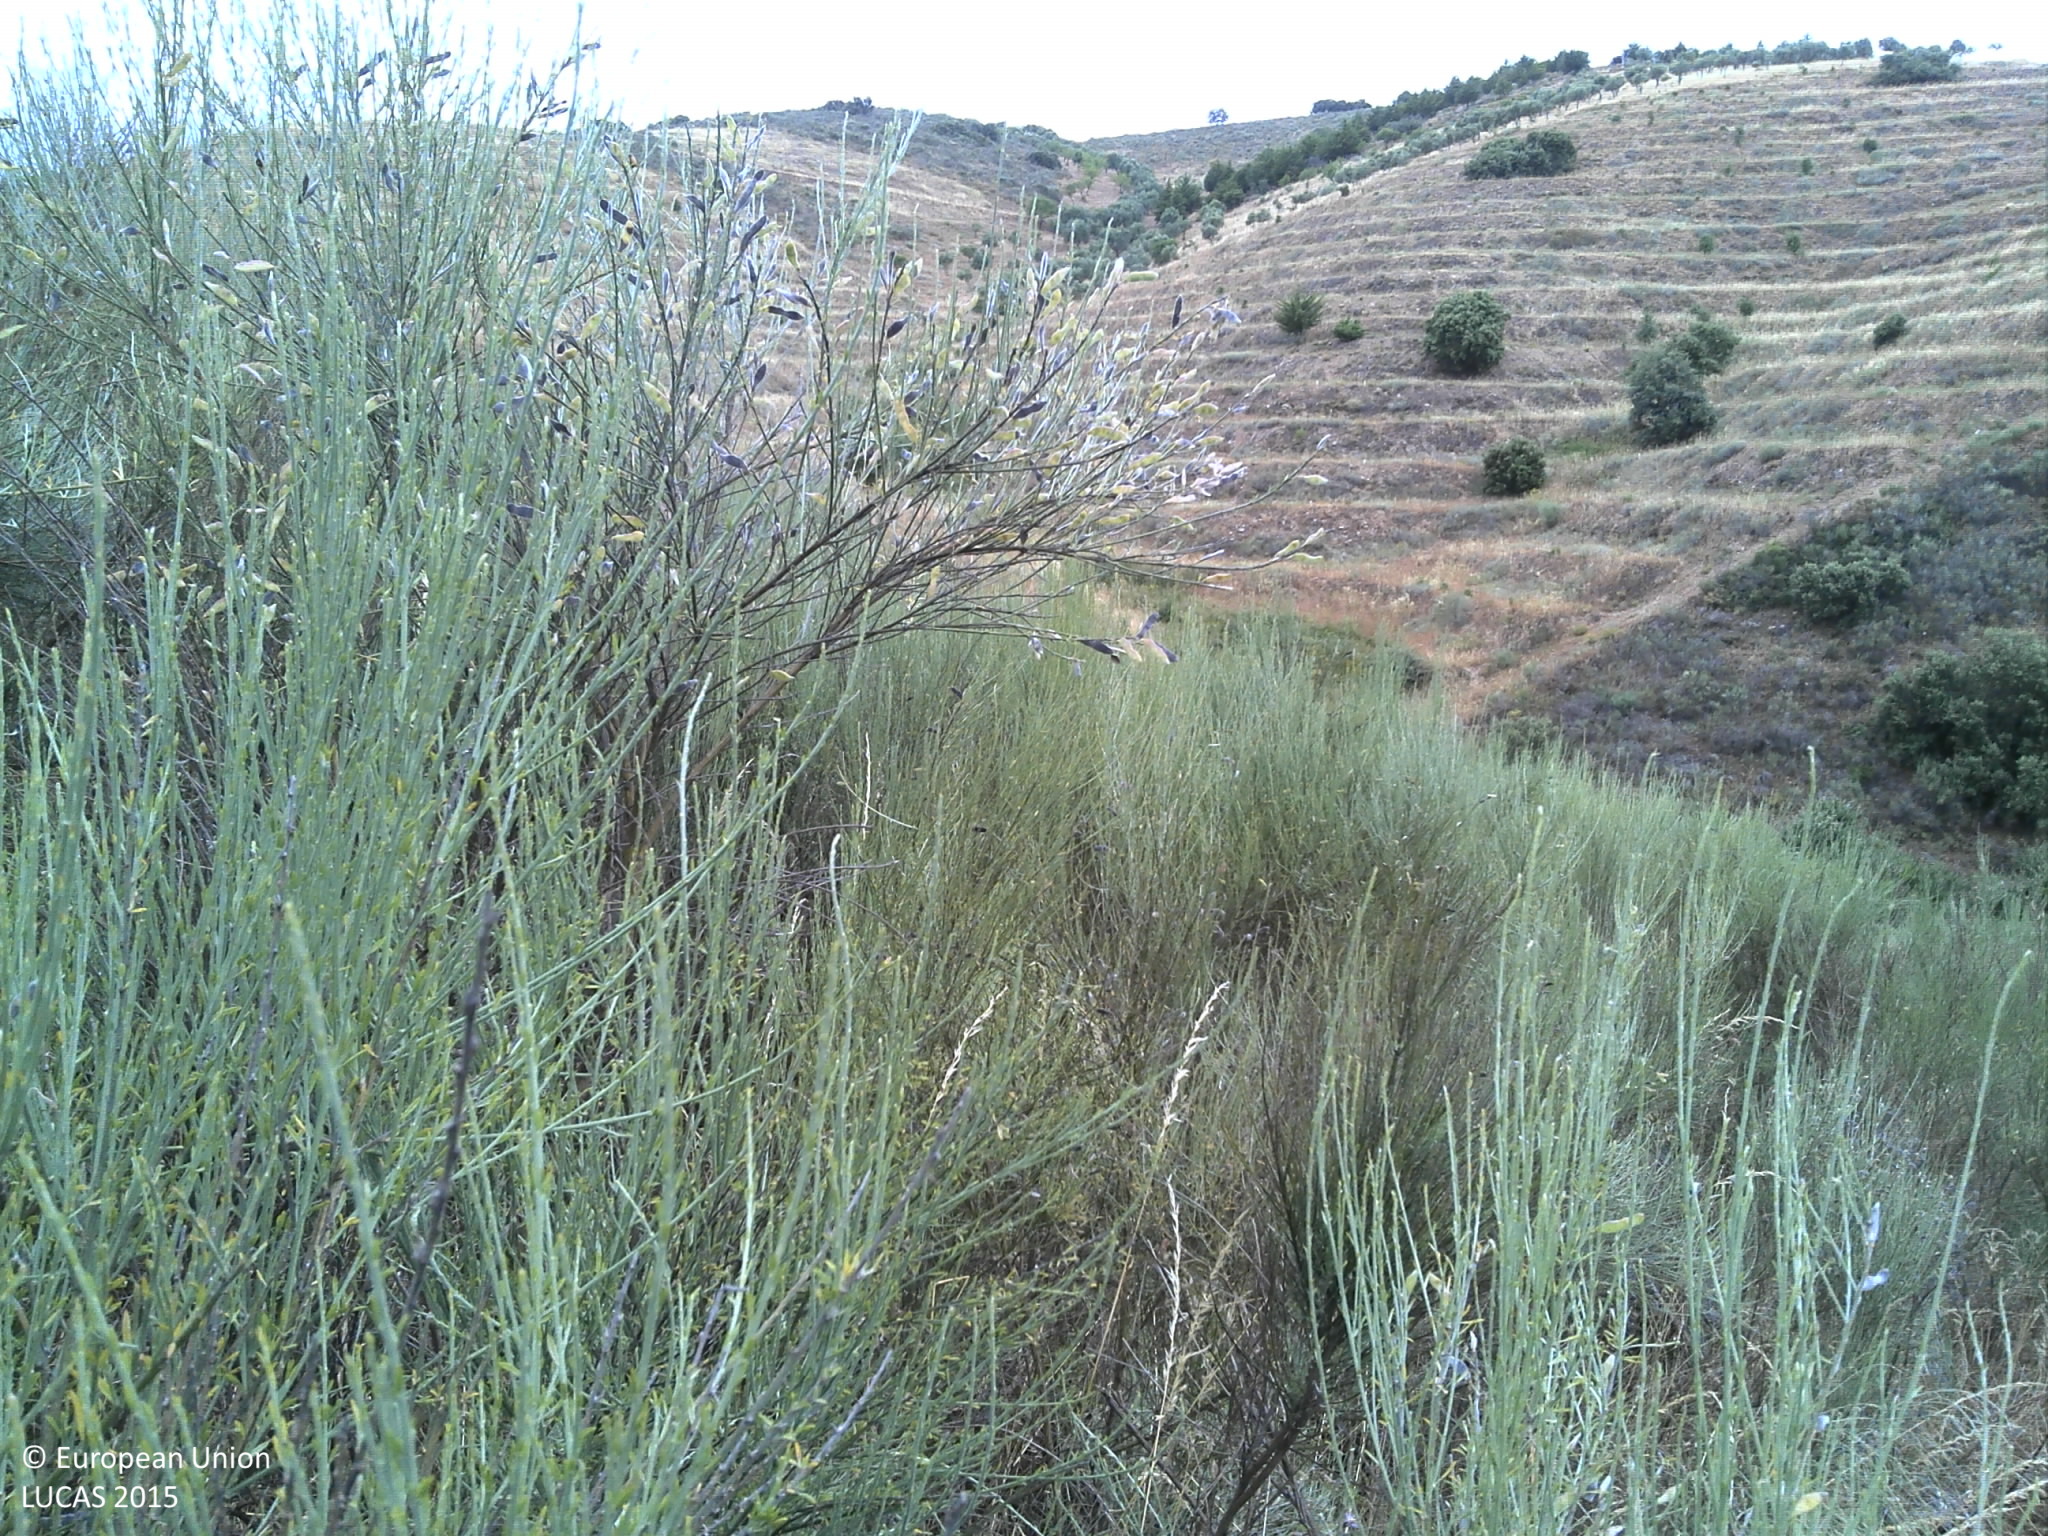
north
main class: Shrubland
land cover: Shrubland without tree cover
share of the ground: > 75 %
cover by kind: shrubs 100 %
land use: Semi-natural and natural areas not in use
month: June
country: PT
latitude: 41.3206
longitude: -6.9676
